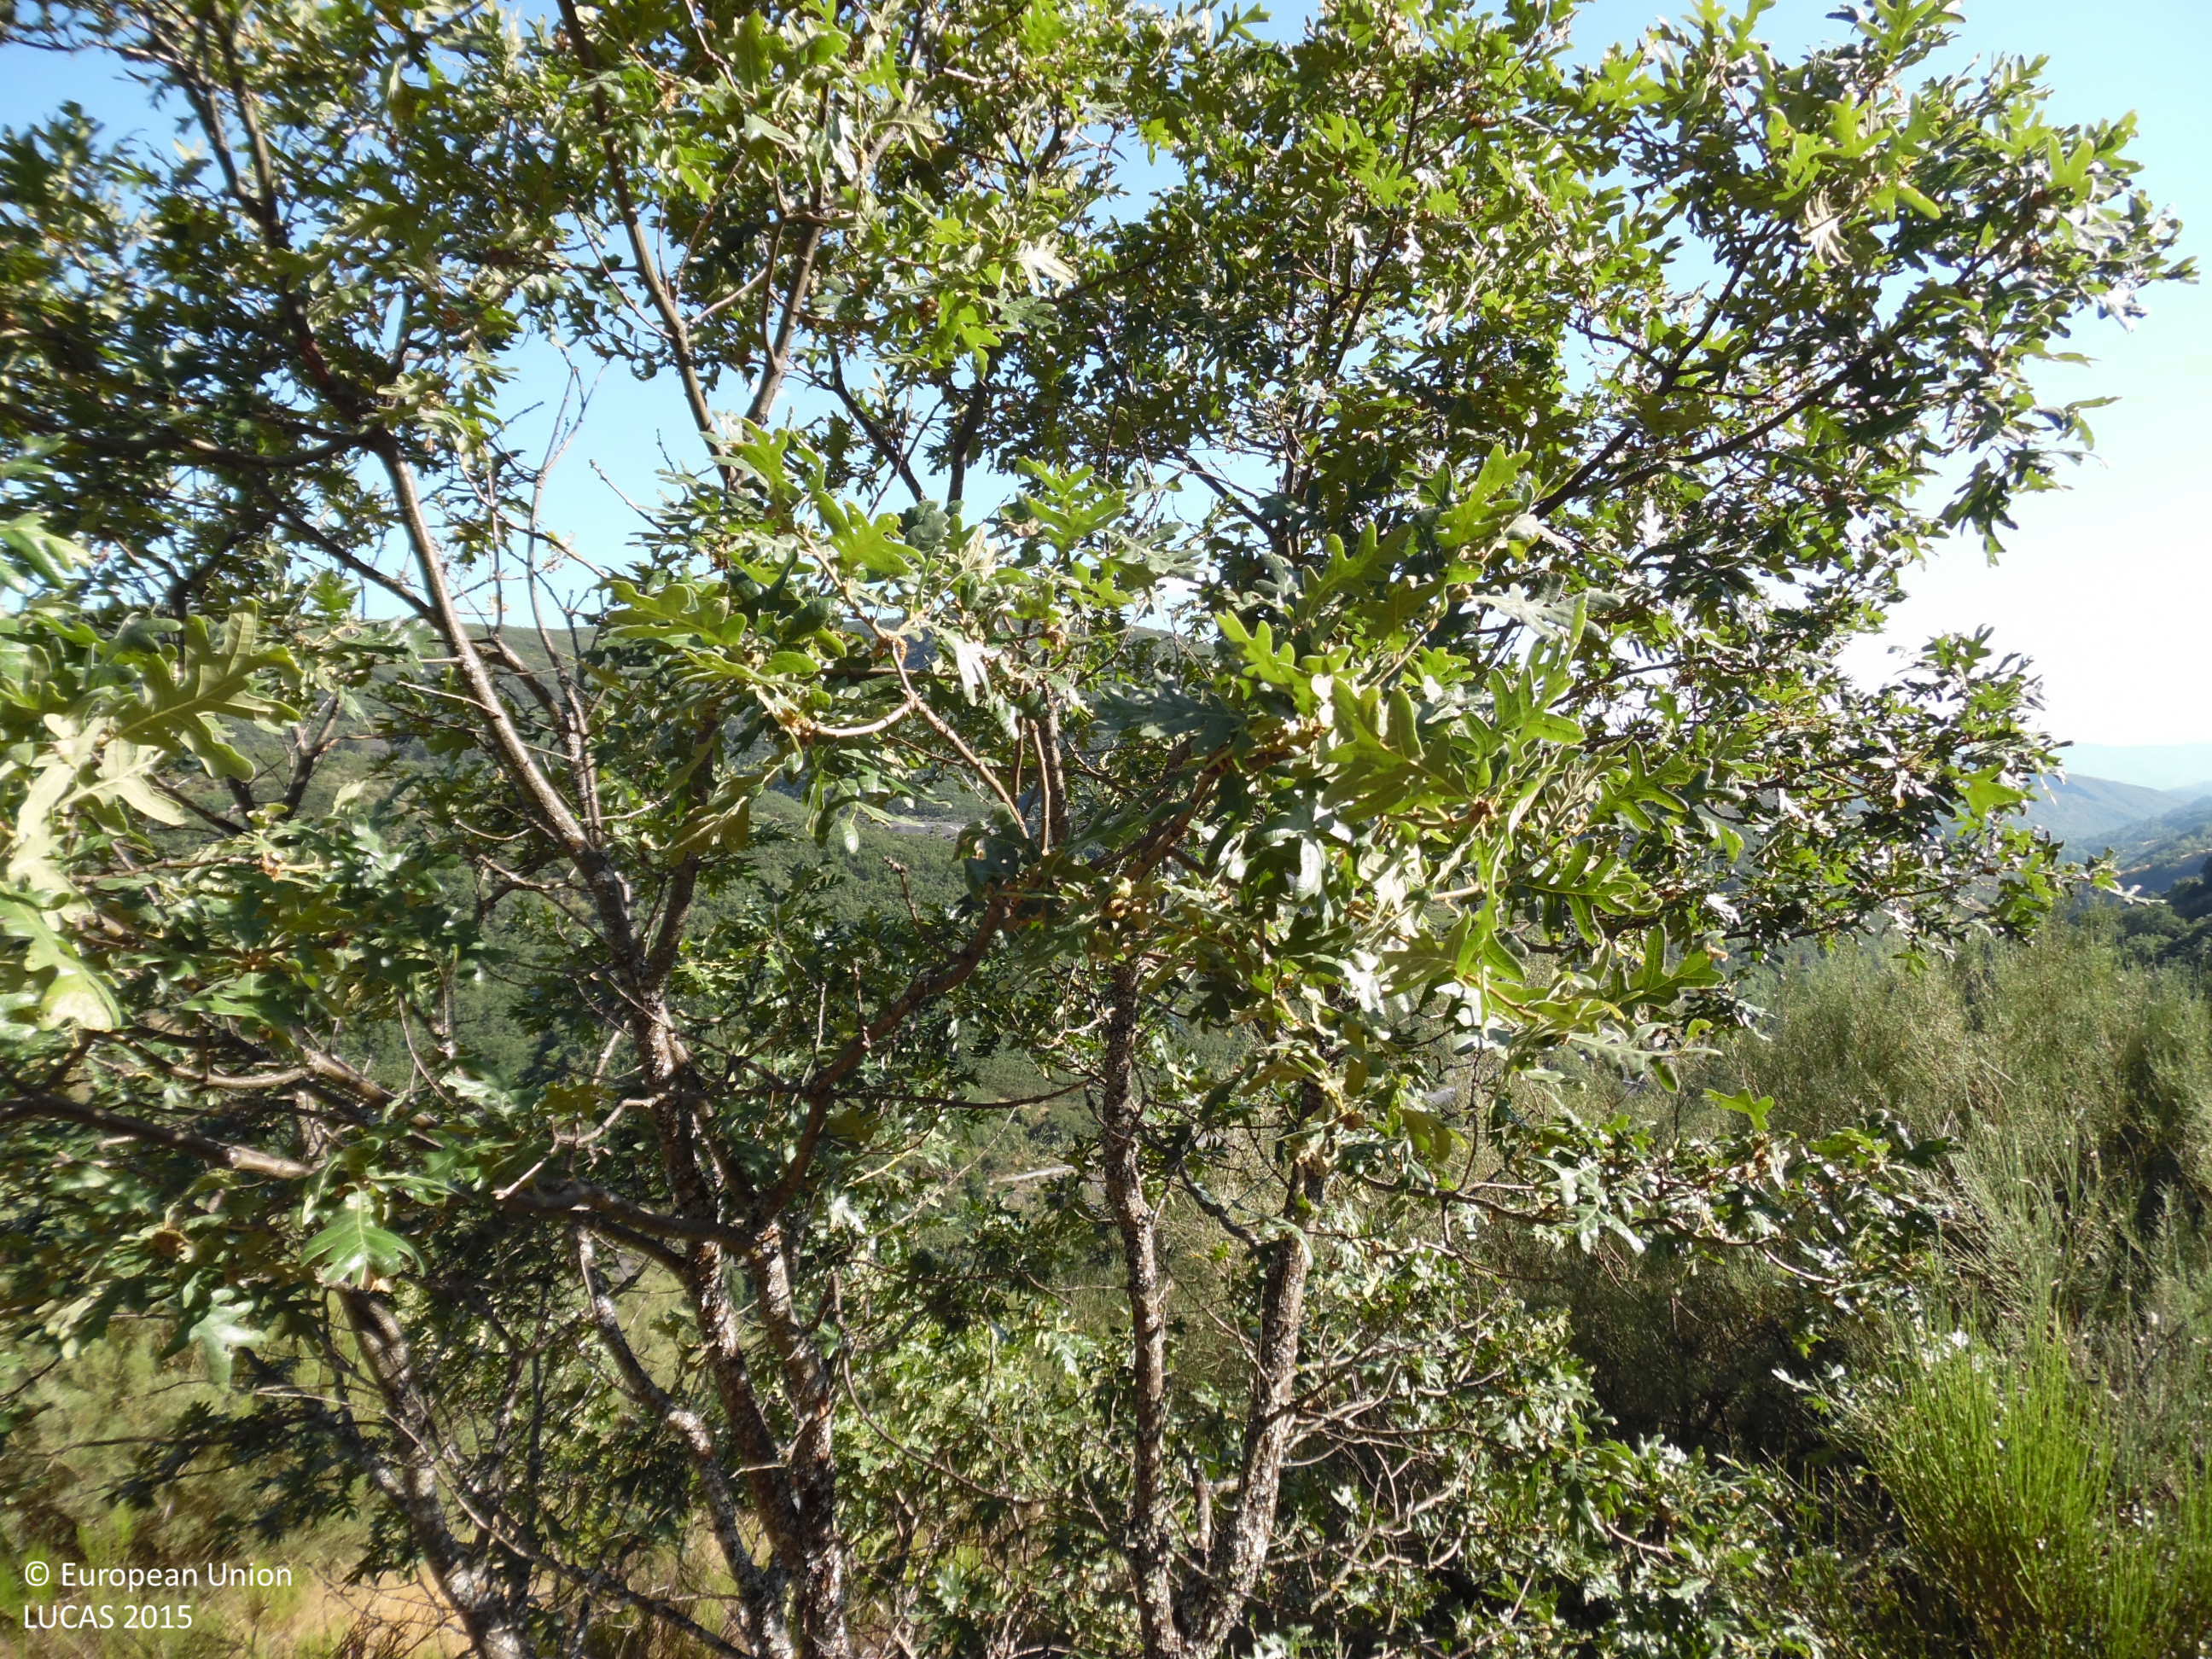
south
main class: Shrubland
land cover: Shrubland with sparse tree cover
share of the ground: > 75 %
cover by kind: shrubs 95 %, broadleaved forest trees 5 %
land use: Abandoned areas
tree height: > 5 m
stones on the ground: 10 - 25 %
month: August
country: ES
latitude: 42.7367
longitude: -6.1995
